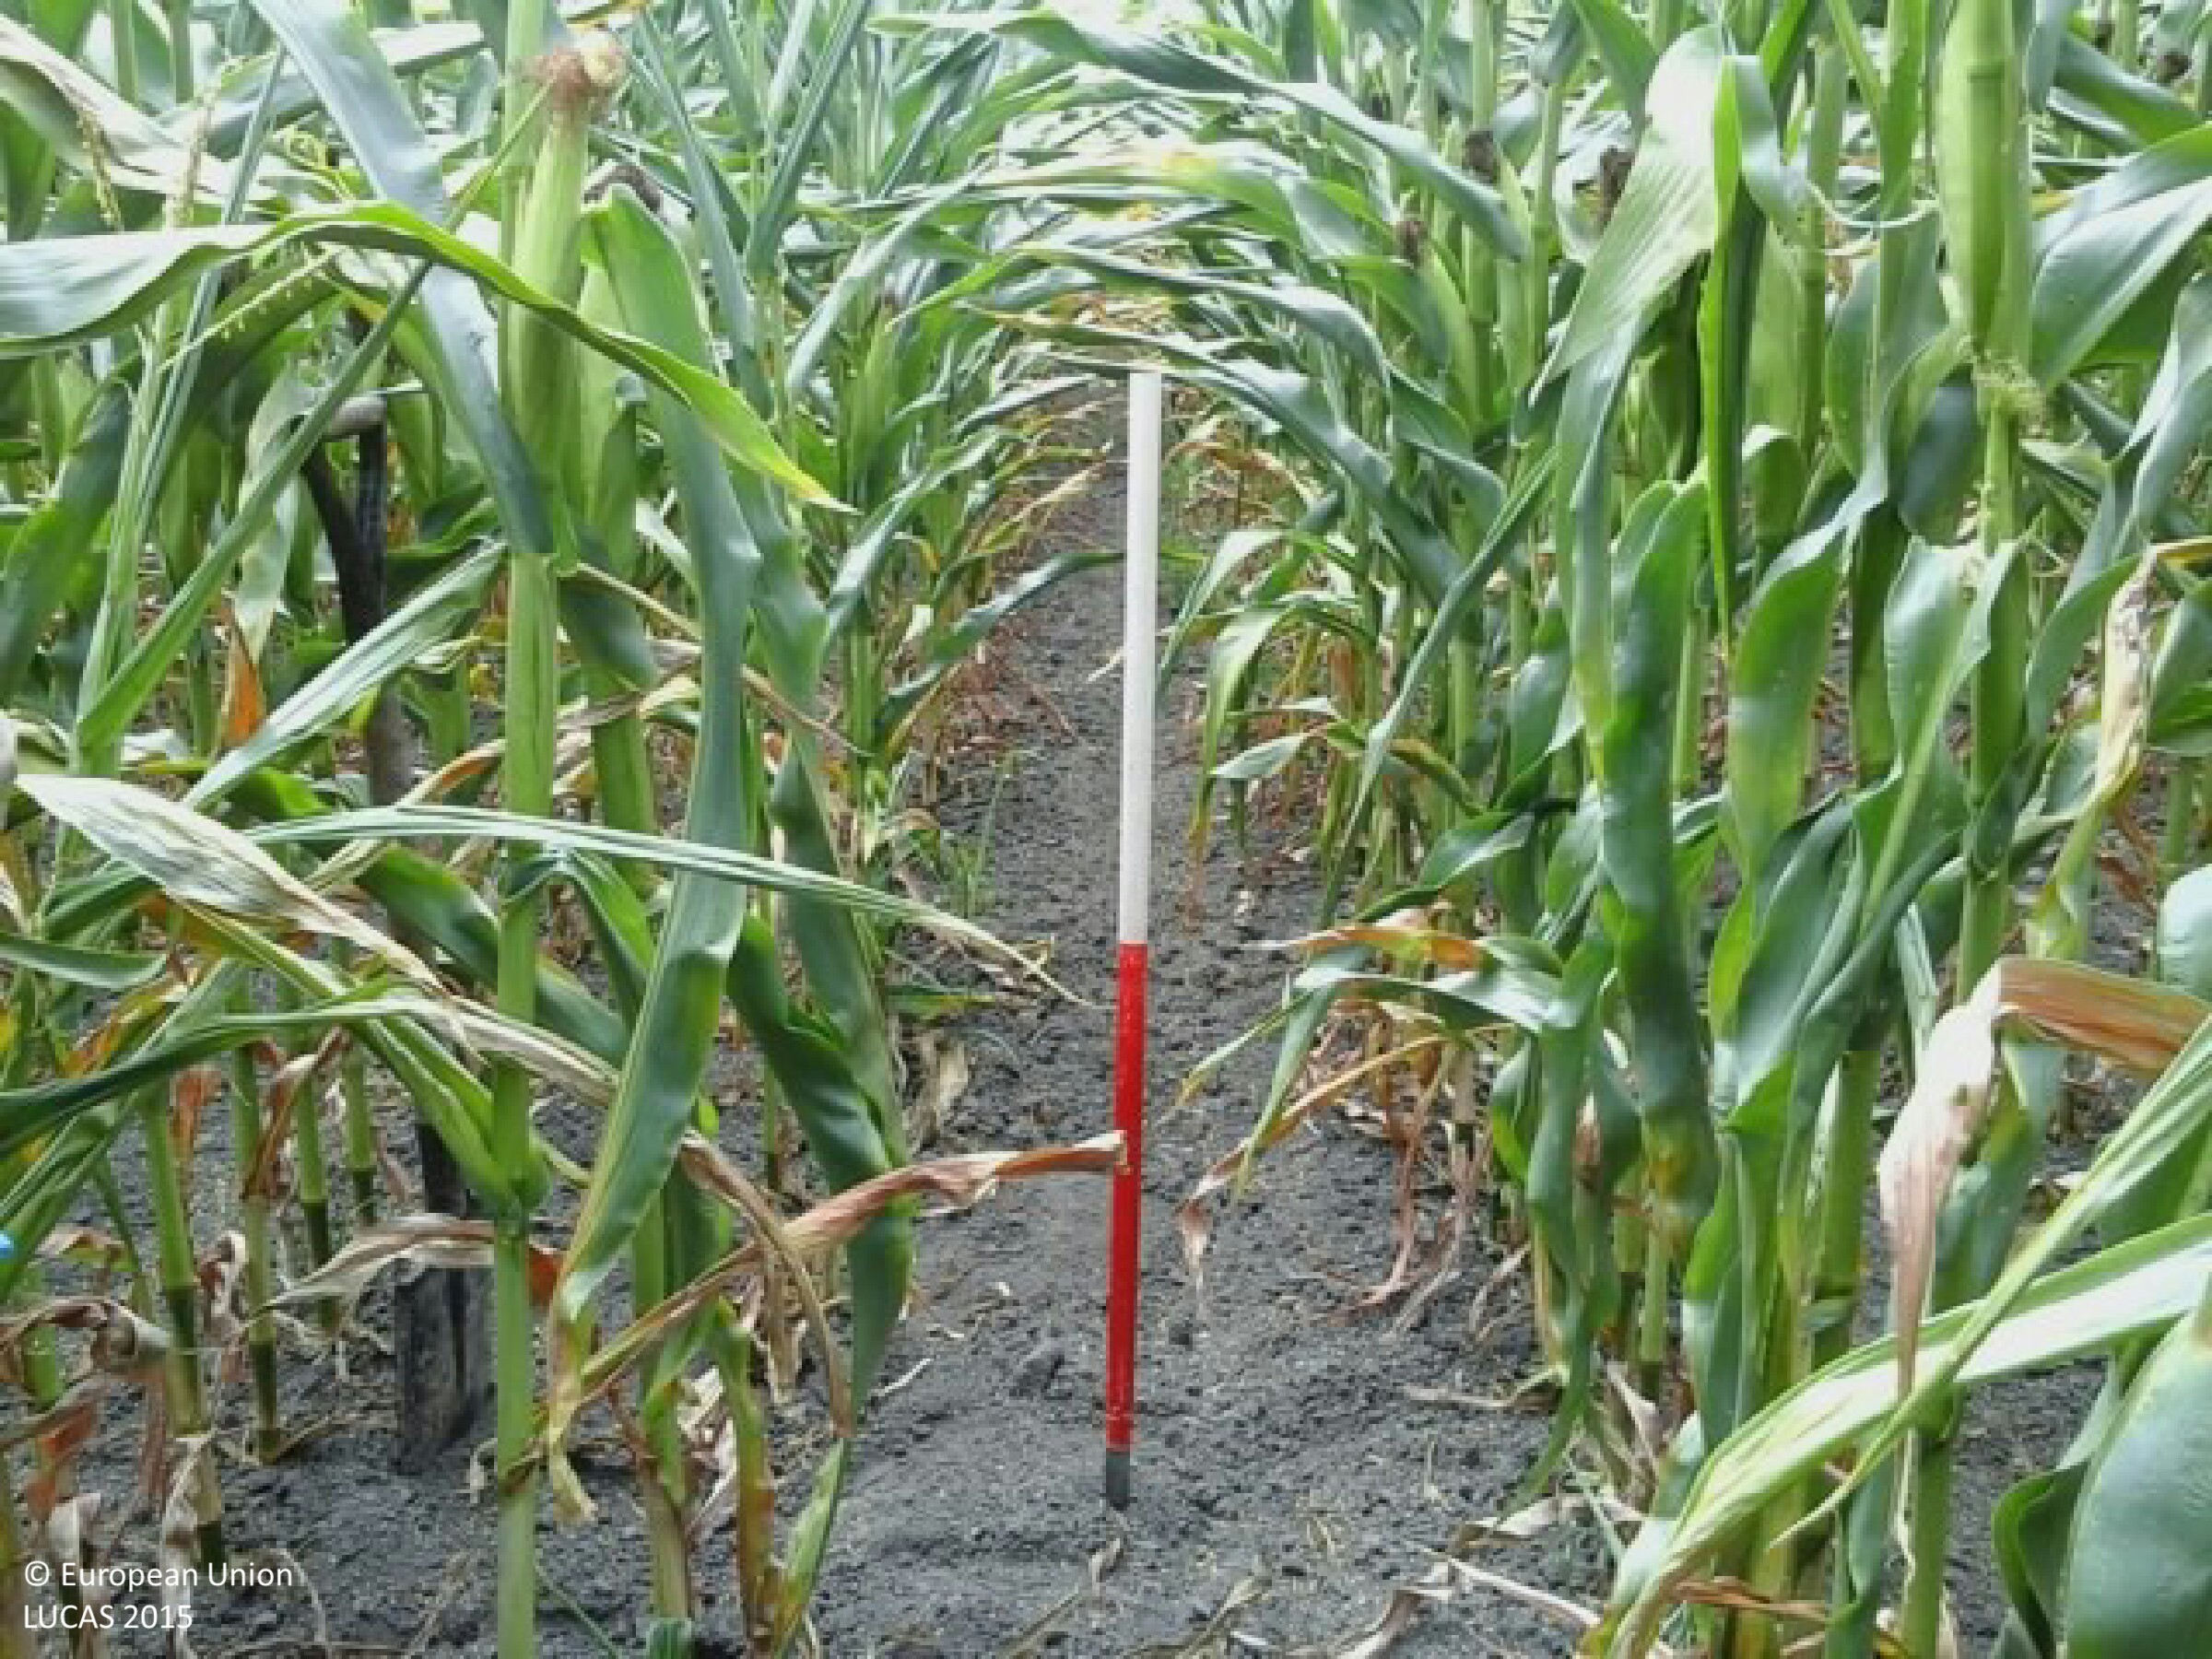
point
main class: Cropland
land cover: Maize
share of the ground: > 75 %
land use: Agriculture (excluding fallow land and kitchen gardens)
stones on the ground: < 10 %
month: July
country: HU
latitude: 46.2223
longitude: 18.8141
